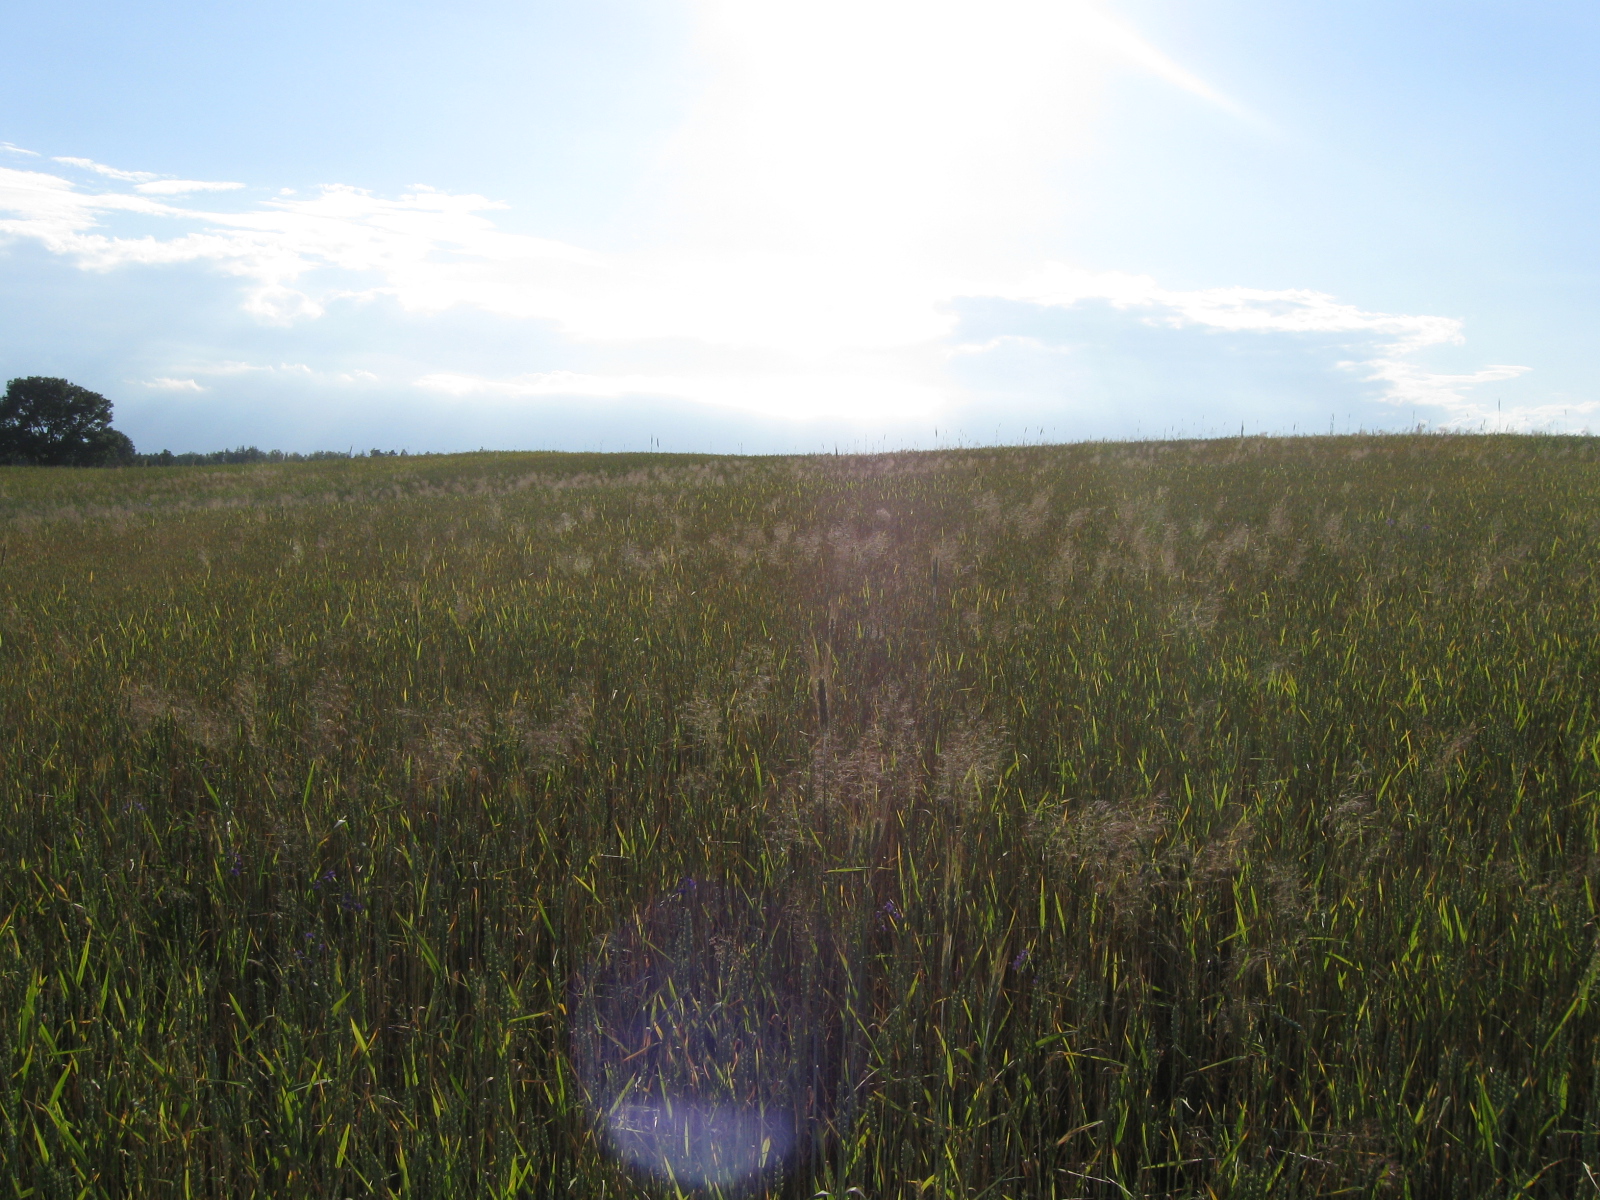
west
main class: Cropland
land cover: Common wheat
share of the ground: > 75 %
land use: Agriculture (excluding fallow land and kitchen gardens)
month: June
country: LT
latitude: 54.2372
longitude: 24.2285
